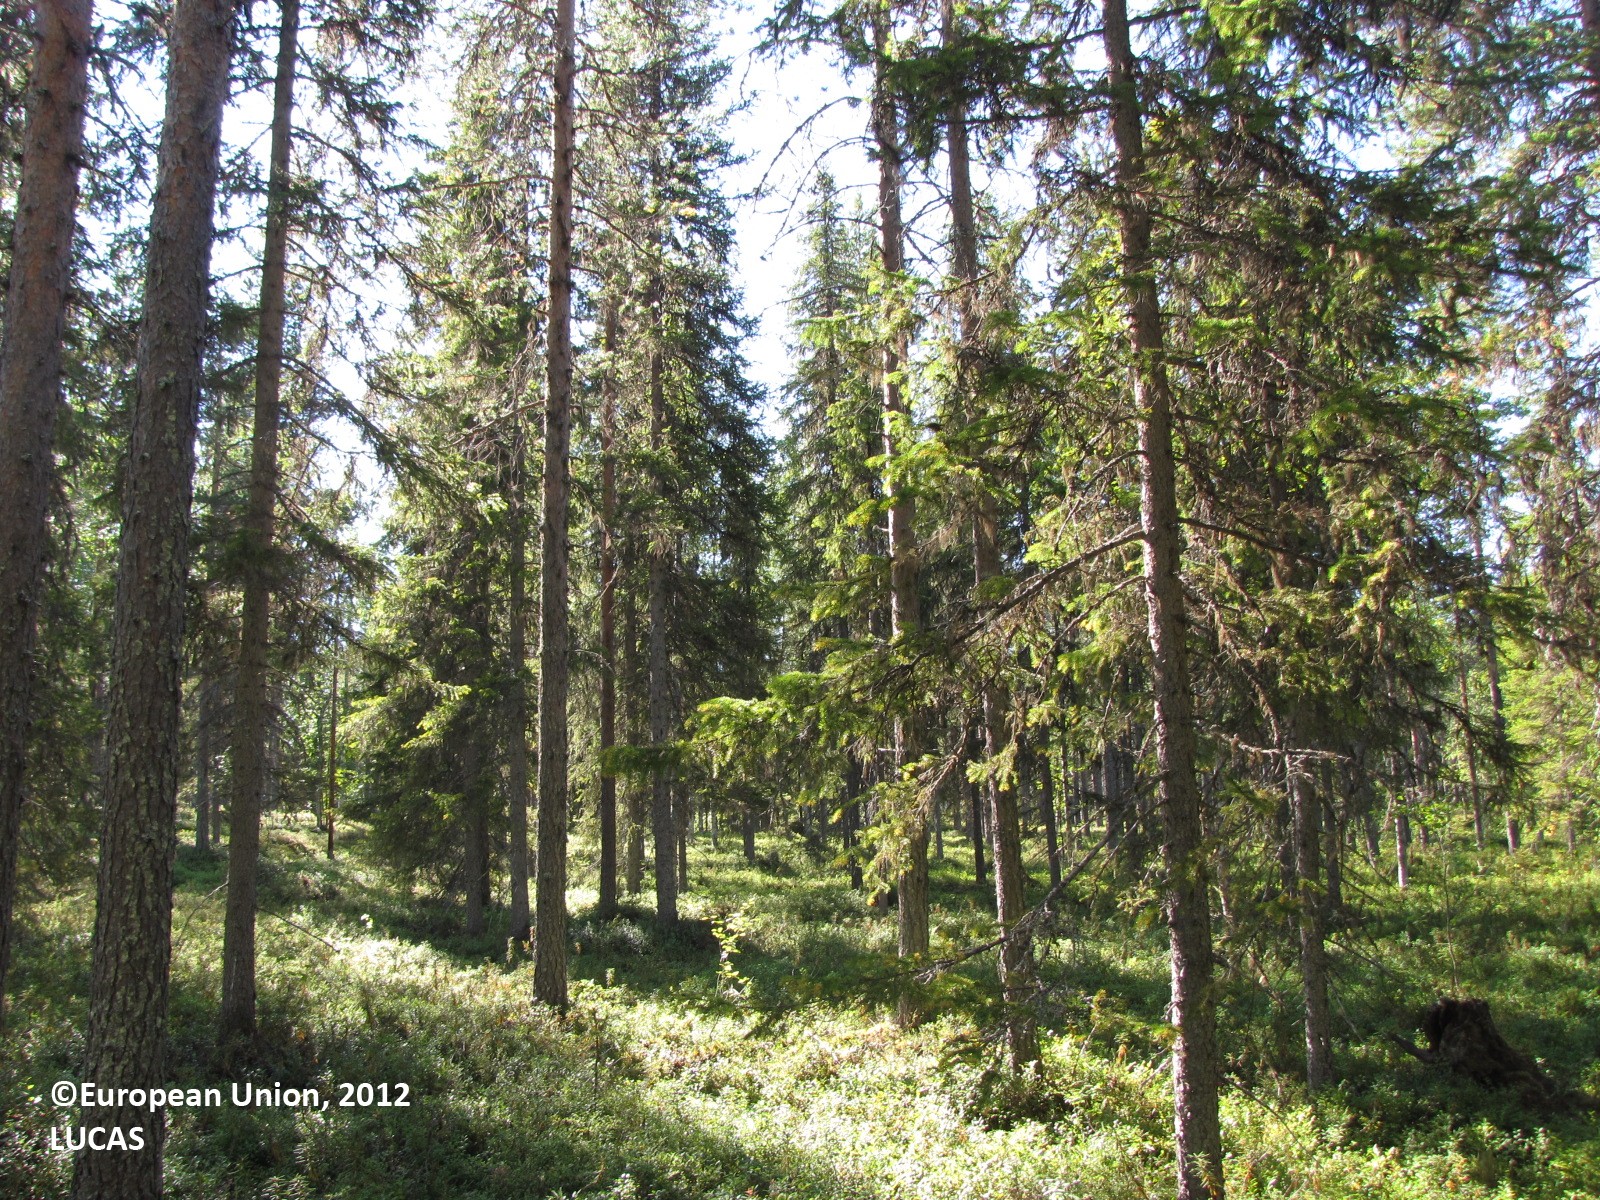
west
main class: Woodland
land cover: Other coniferous woodland
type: boreal forest
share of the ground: 50 - 75 %
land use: Forestry
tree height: > 5 m
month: August
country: FI
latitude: 66.9329
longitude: 25.2157
